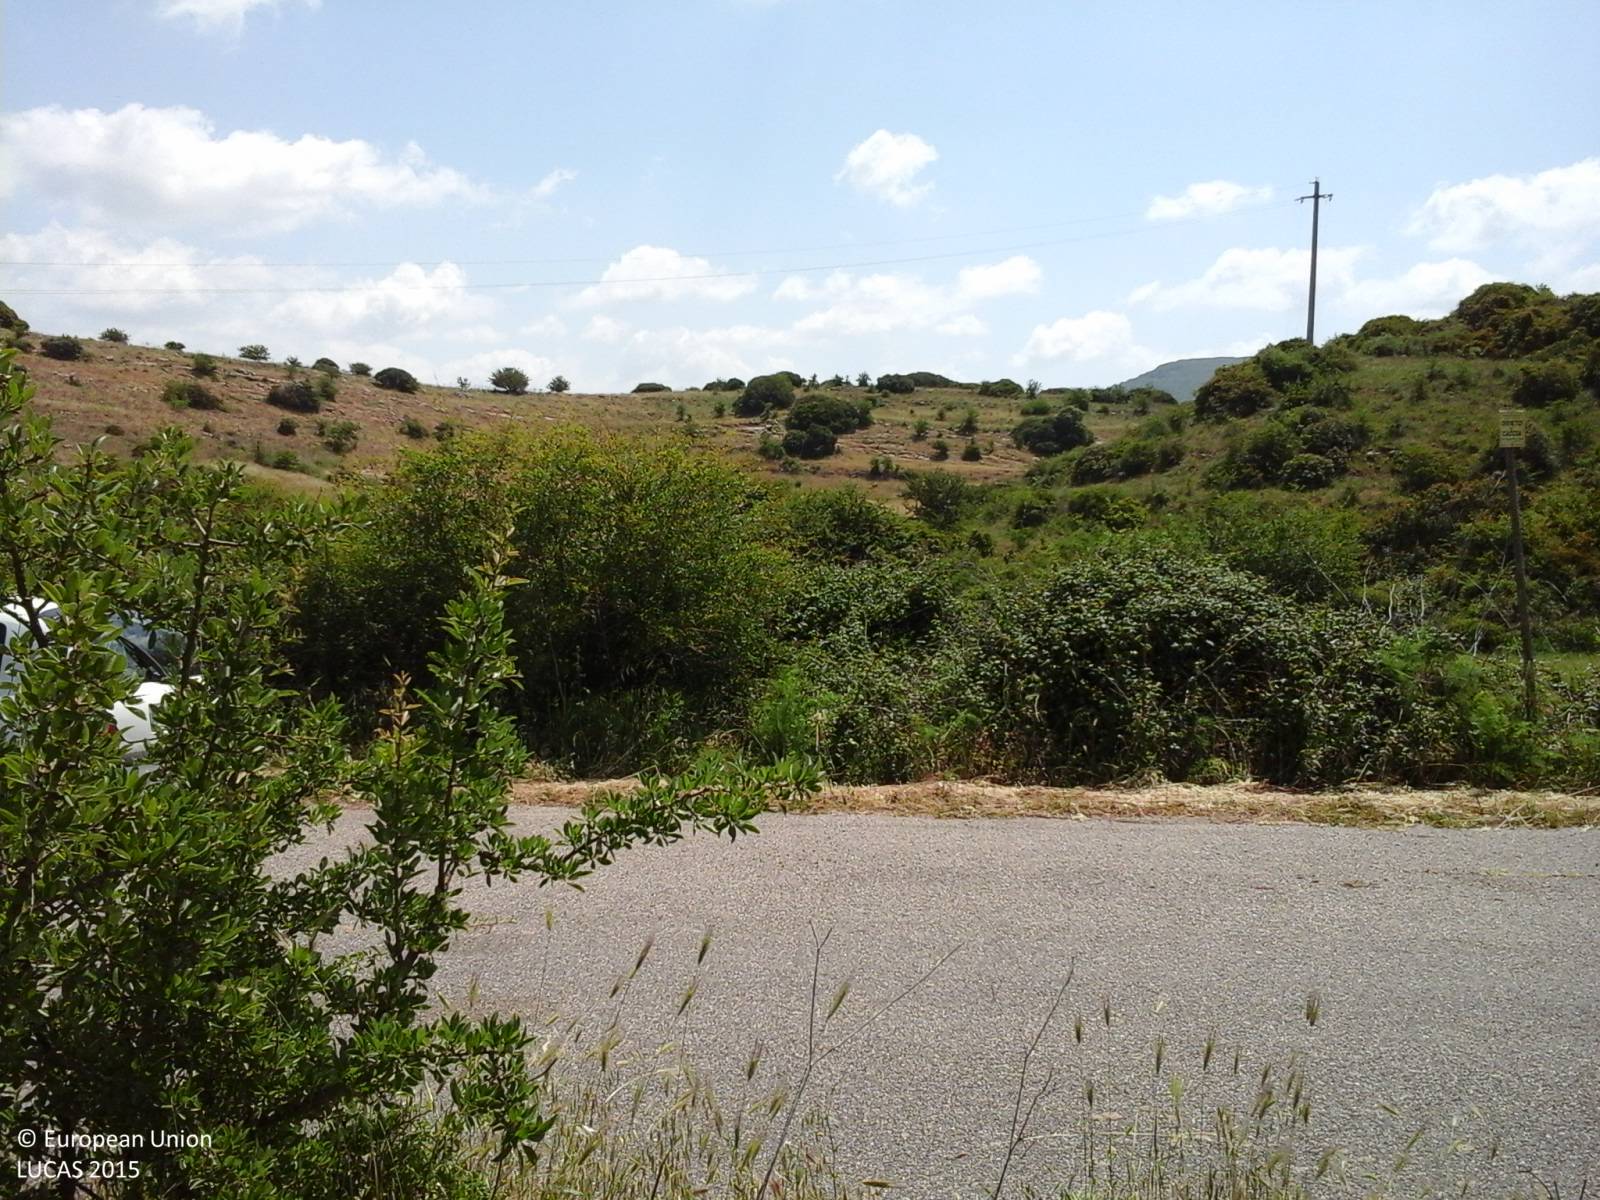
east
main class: Cropland
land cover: Other leguminous and mixtures for fodder
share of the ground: > 75 %
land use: Agriculture (excluding fallow land and kitchen gardens)
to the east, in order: Other leguminous and mixtures for fodder; Electric lines; Fences; Grass margins; Ditches and canals; Grass margins; Paved roads, cycling and walking lanes; Grass margins; Abandoned hedges; Durum wheat; Shrubland with sparse tree cover; Arable land (only in case pi); Abandoned hedges; Arable land (only in case pi); Abandoned hedges; Grassland with sparse tree/shrub cover
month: May
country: IT
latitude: 39.8082
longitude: 8.8733
